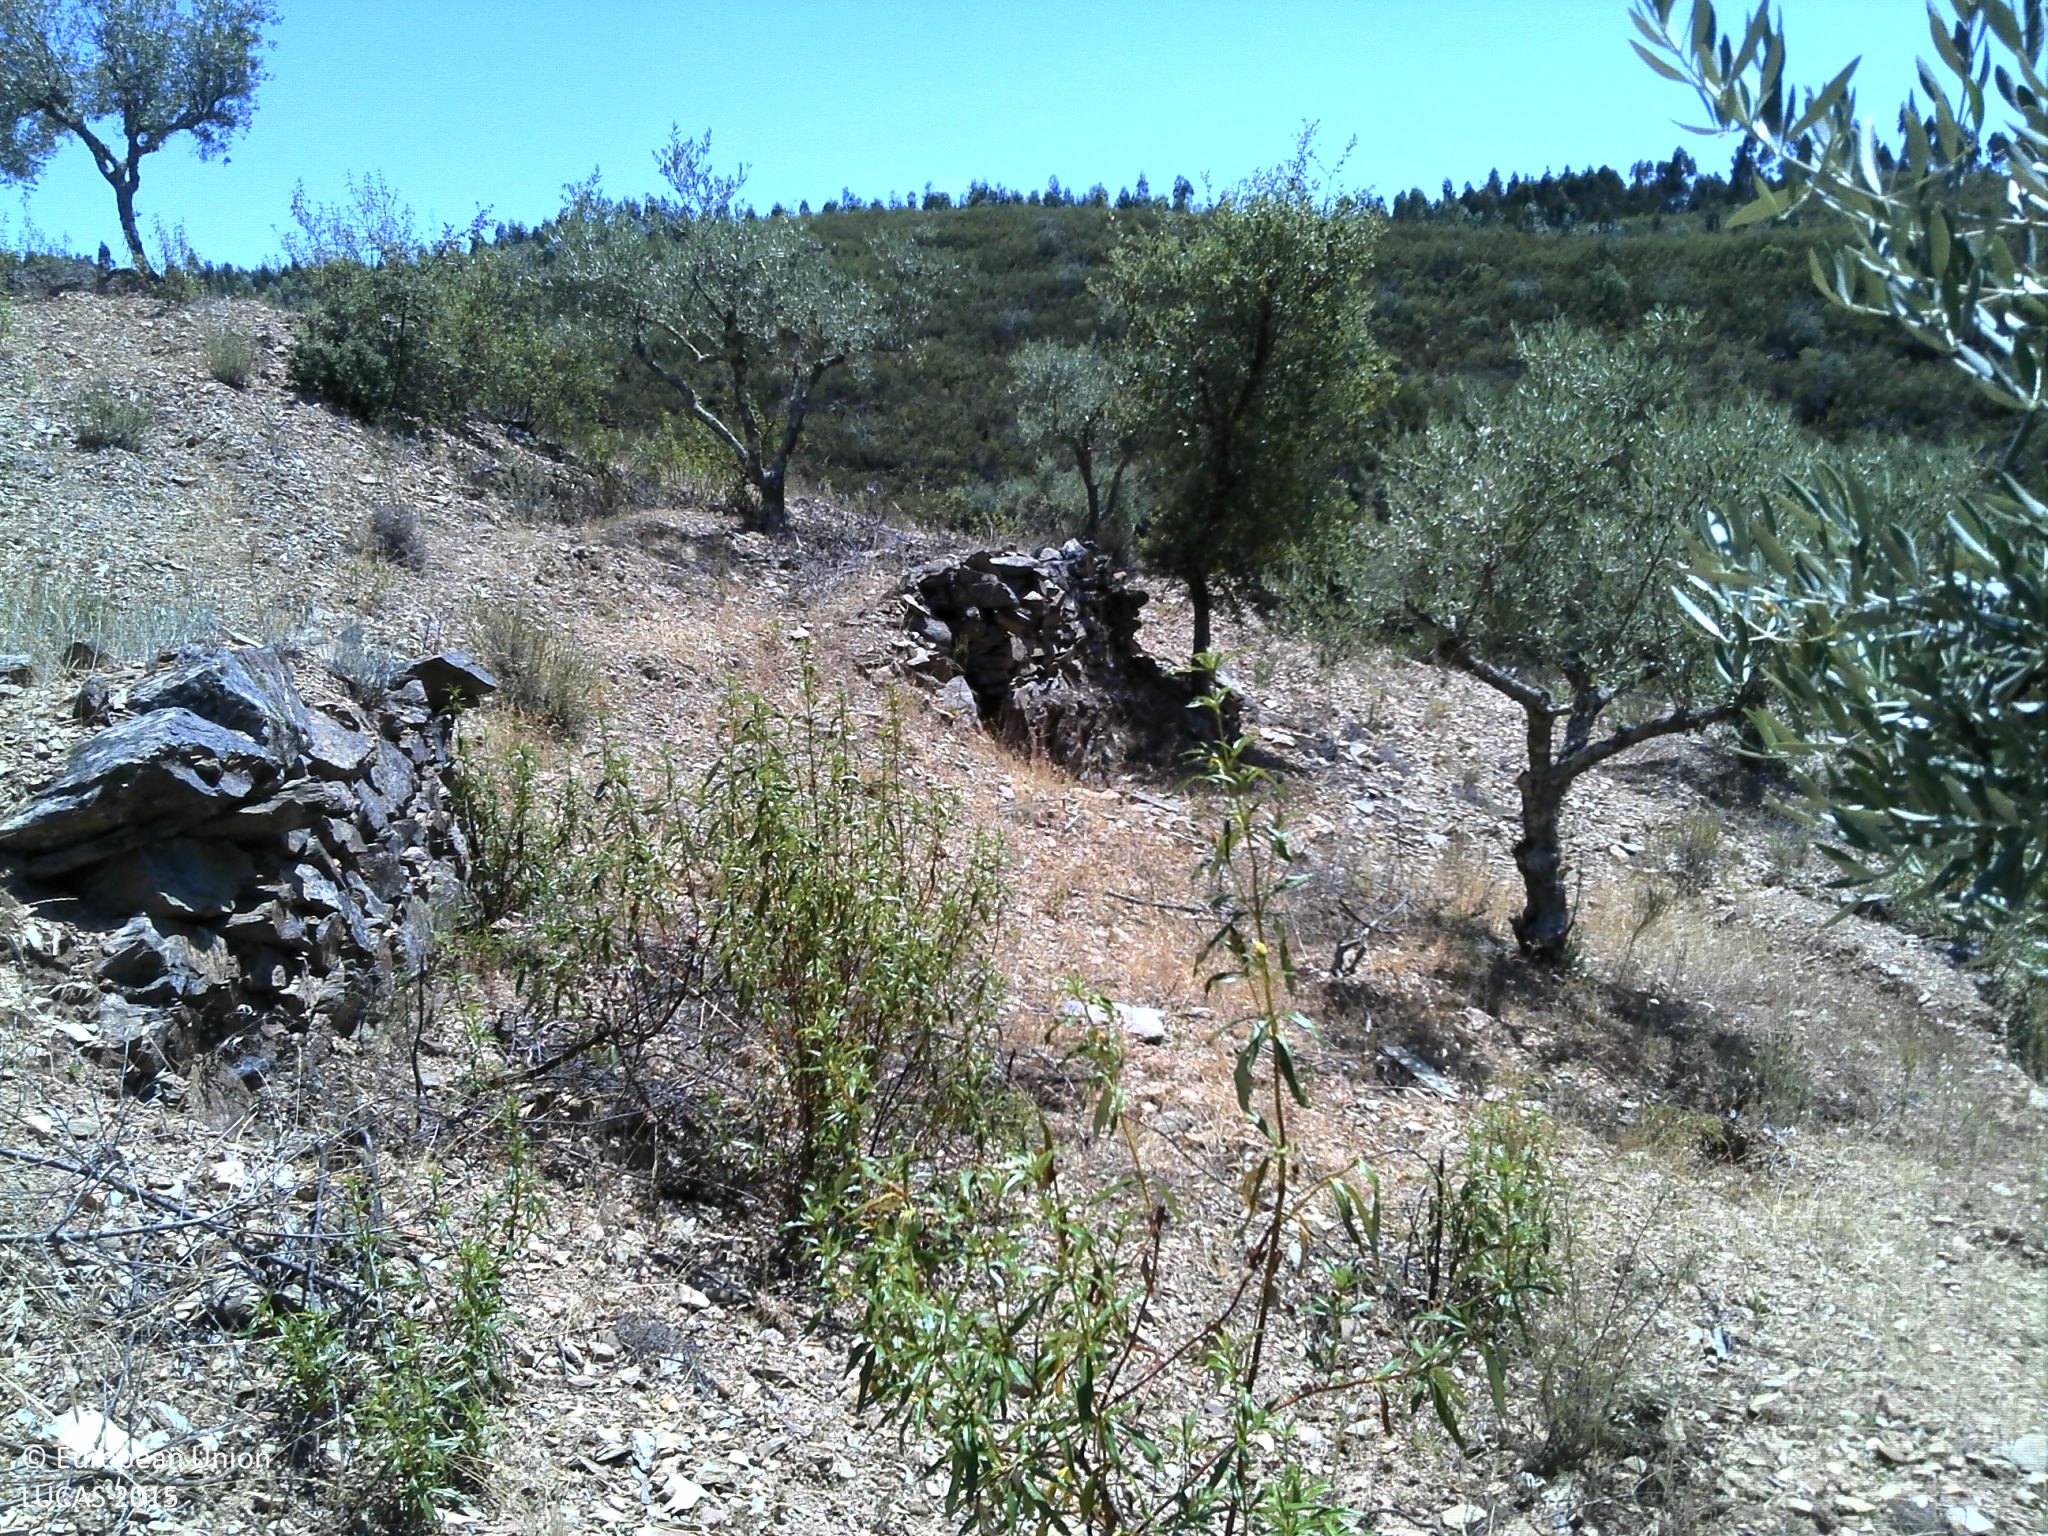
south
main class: Cropland
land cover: Olive groves
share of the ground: 10 - 25 %
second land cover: Shrubland without tree cover
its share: 10 - 25 %
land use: Agriculture (excluding fallow land and kitchen gardens)
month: July
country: PT
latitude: 39.6486
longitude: -7.7579
